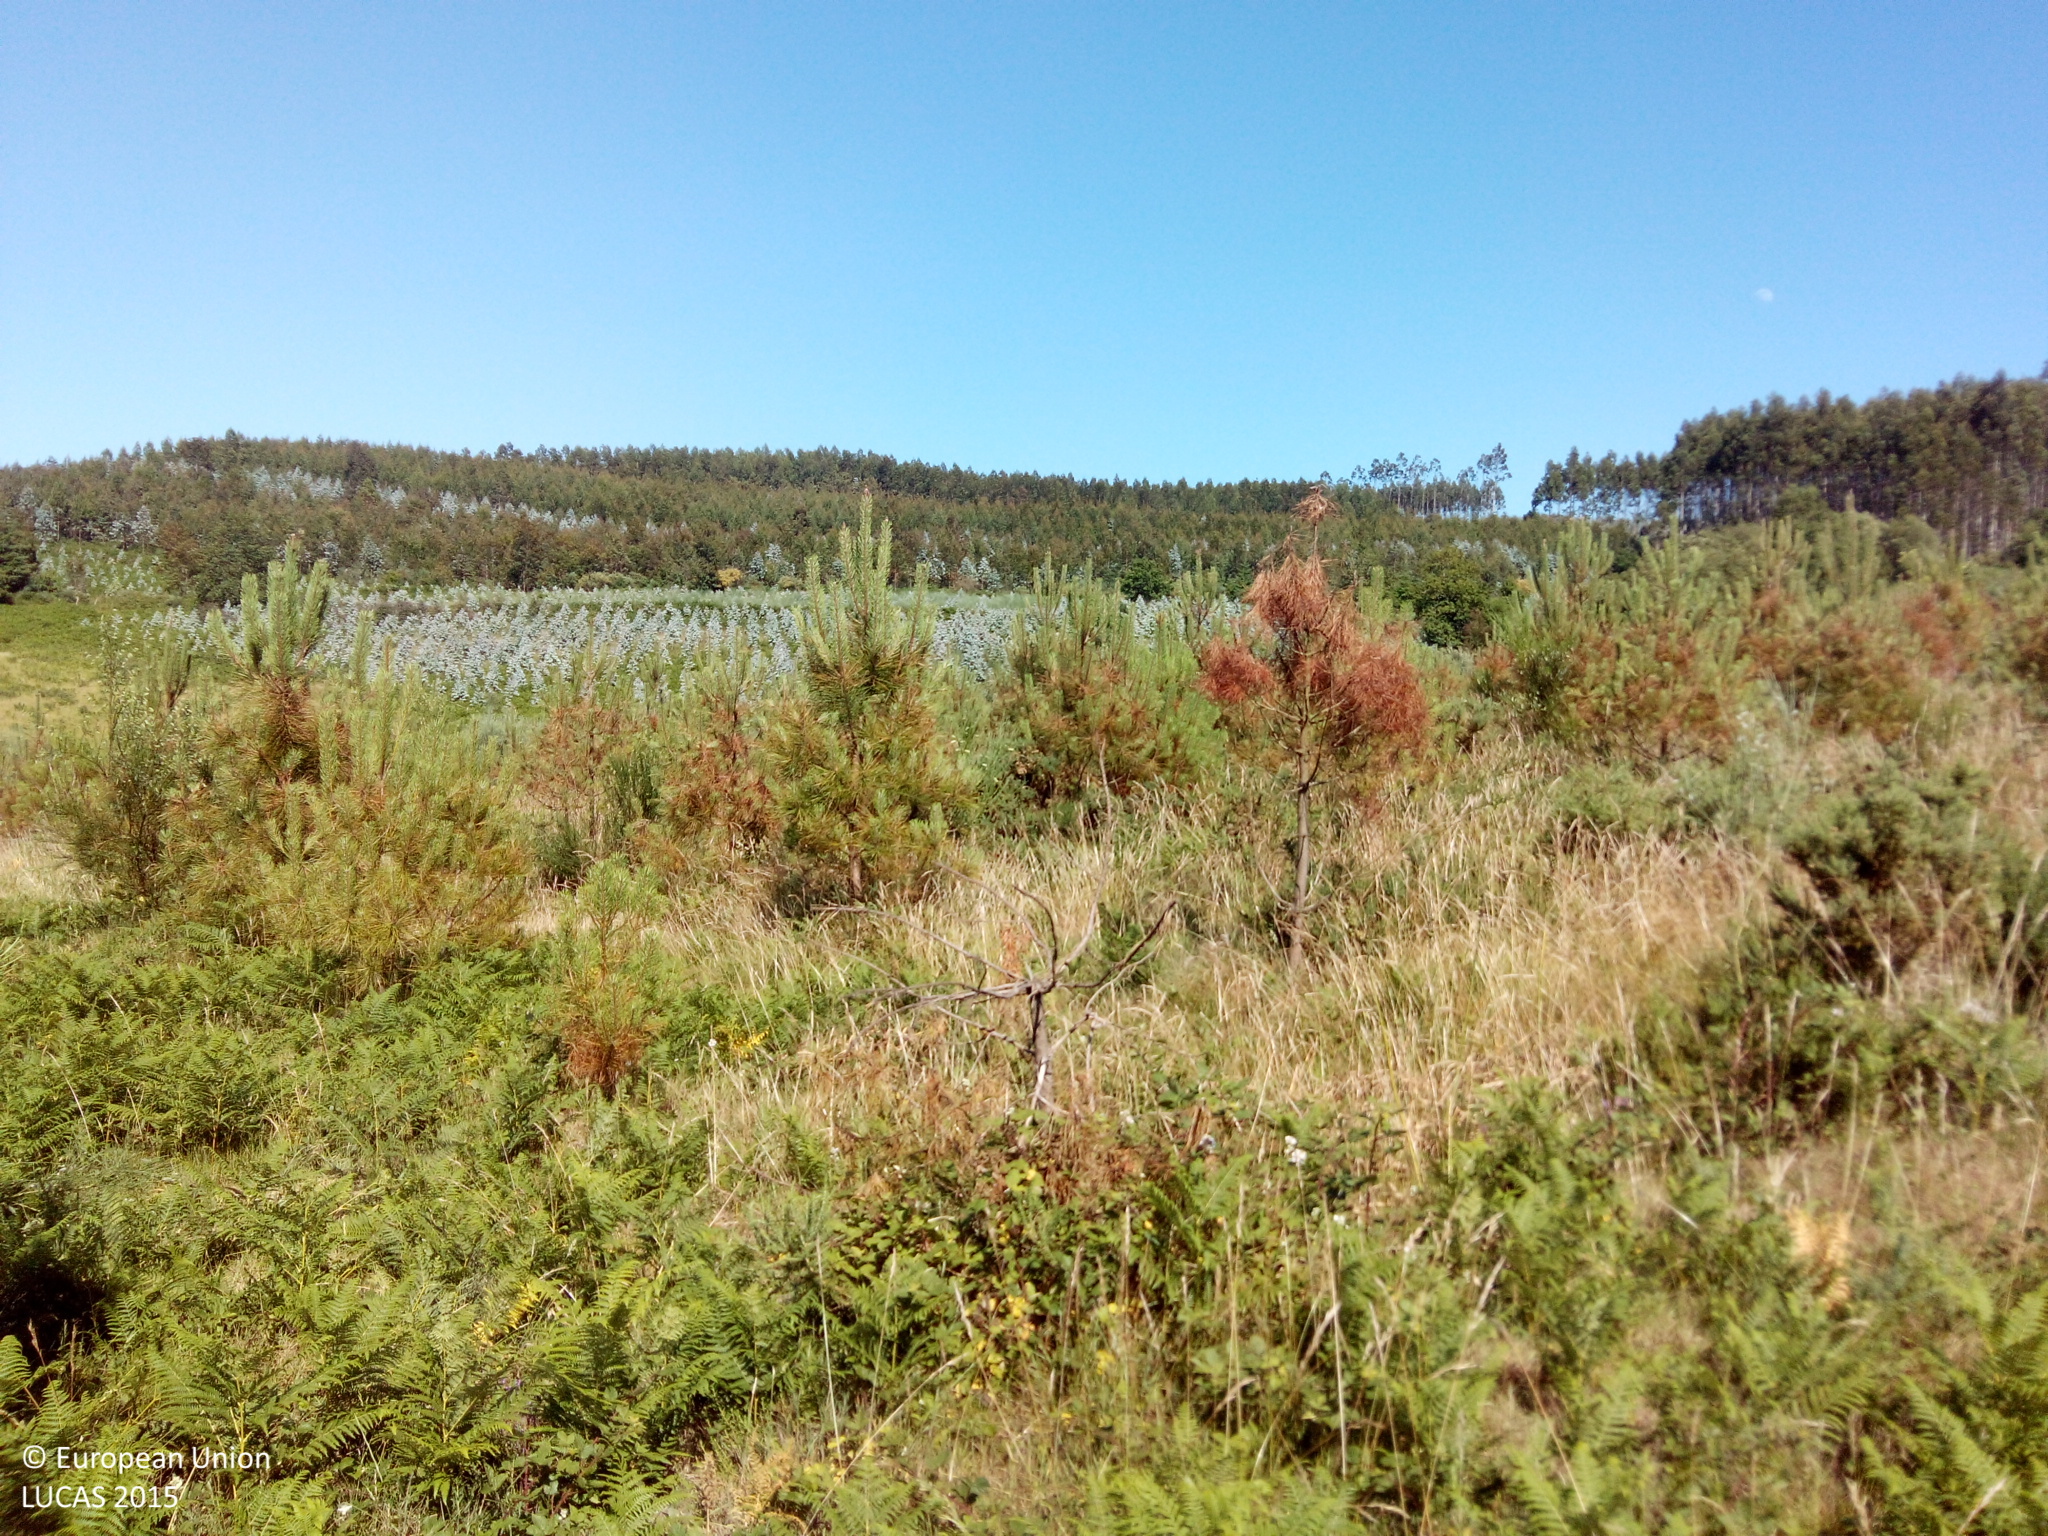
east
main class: Woodland
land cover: Pine dominated coniferous woodland
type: hemiboreal forest and nemoral coniferous forest and mixed broadleaved-coniferous forest
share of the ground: 25 - 50 %
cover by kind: coniferous forest trees 50 %, shrubs 30 %, herbaceous plants 20 %
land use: Forestry
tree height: < 5 m
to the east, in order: Pine dominated coniferous woodland; Abandoned hedges; Rivers and streams; Abandoned hedges; Broadleaved woodland; Fences; Shrubland without tree cover; Dry stone walls; Broadleaved woodland
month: June
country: ES
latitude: 42.9939
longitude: -8.0352
